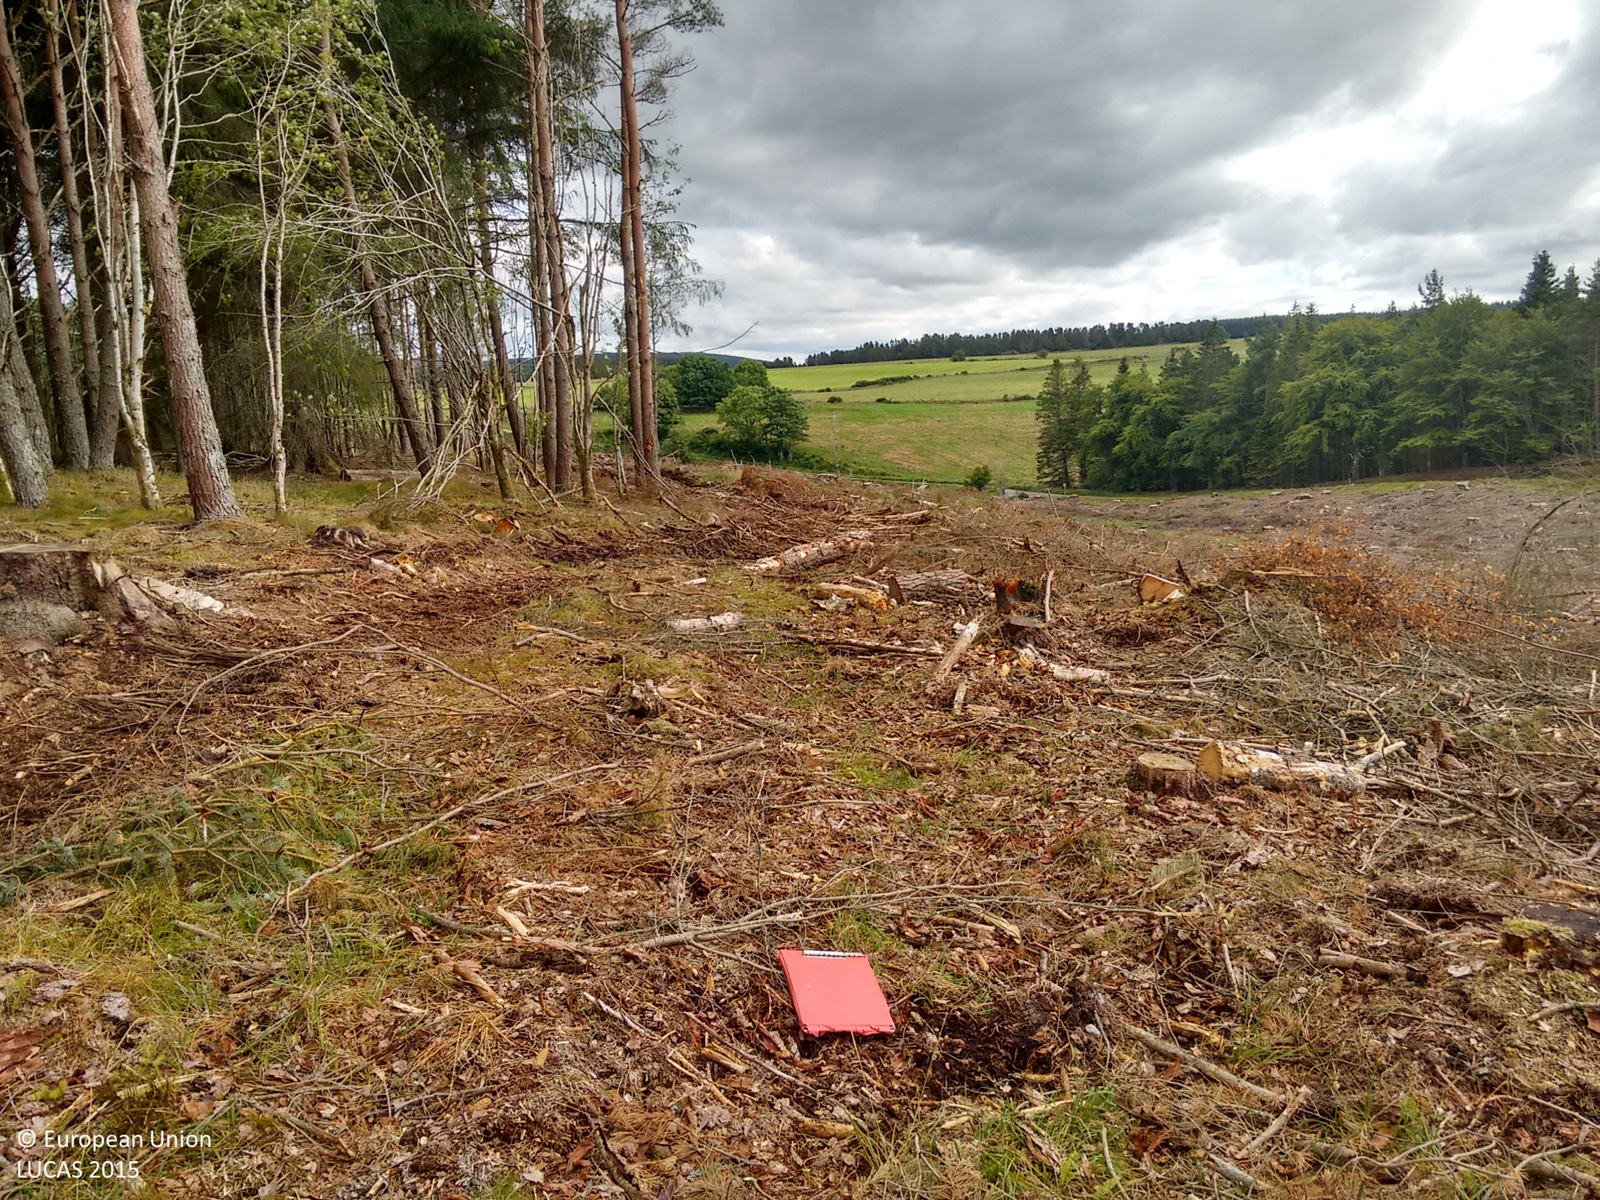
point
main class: Grassland
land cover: Grassland with sparse tree/shrub cover
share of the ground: > 75 %
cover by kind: herbaceous plants 50 %, lichens and mosses 25 %, unconsolidated bare surface 20 %, broadleaved forest trees 5 %
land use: Forestry
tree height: > 5 m
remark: Clear cut
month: August
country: GB
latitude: 57.6514
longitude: -2.8771
